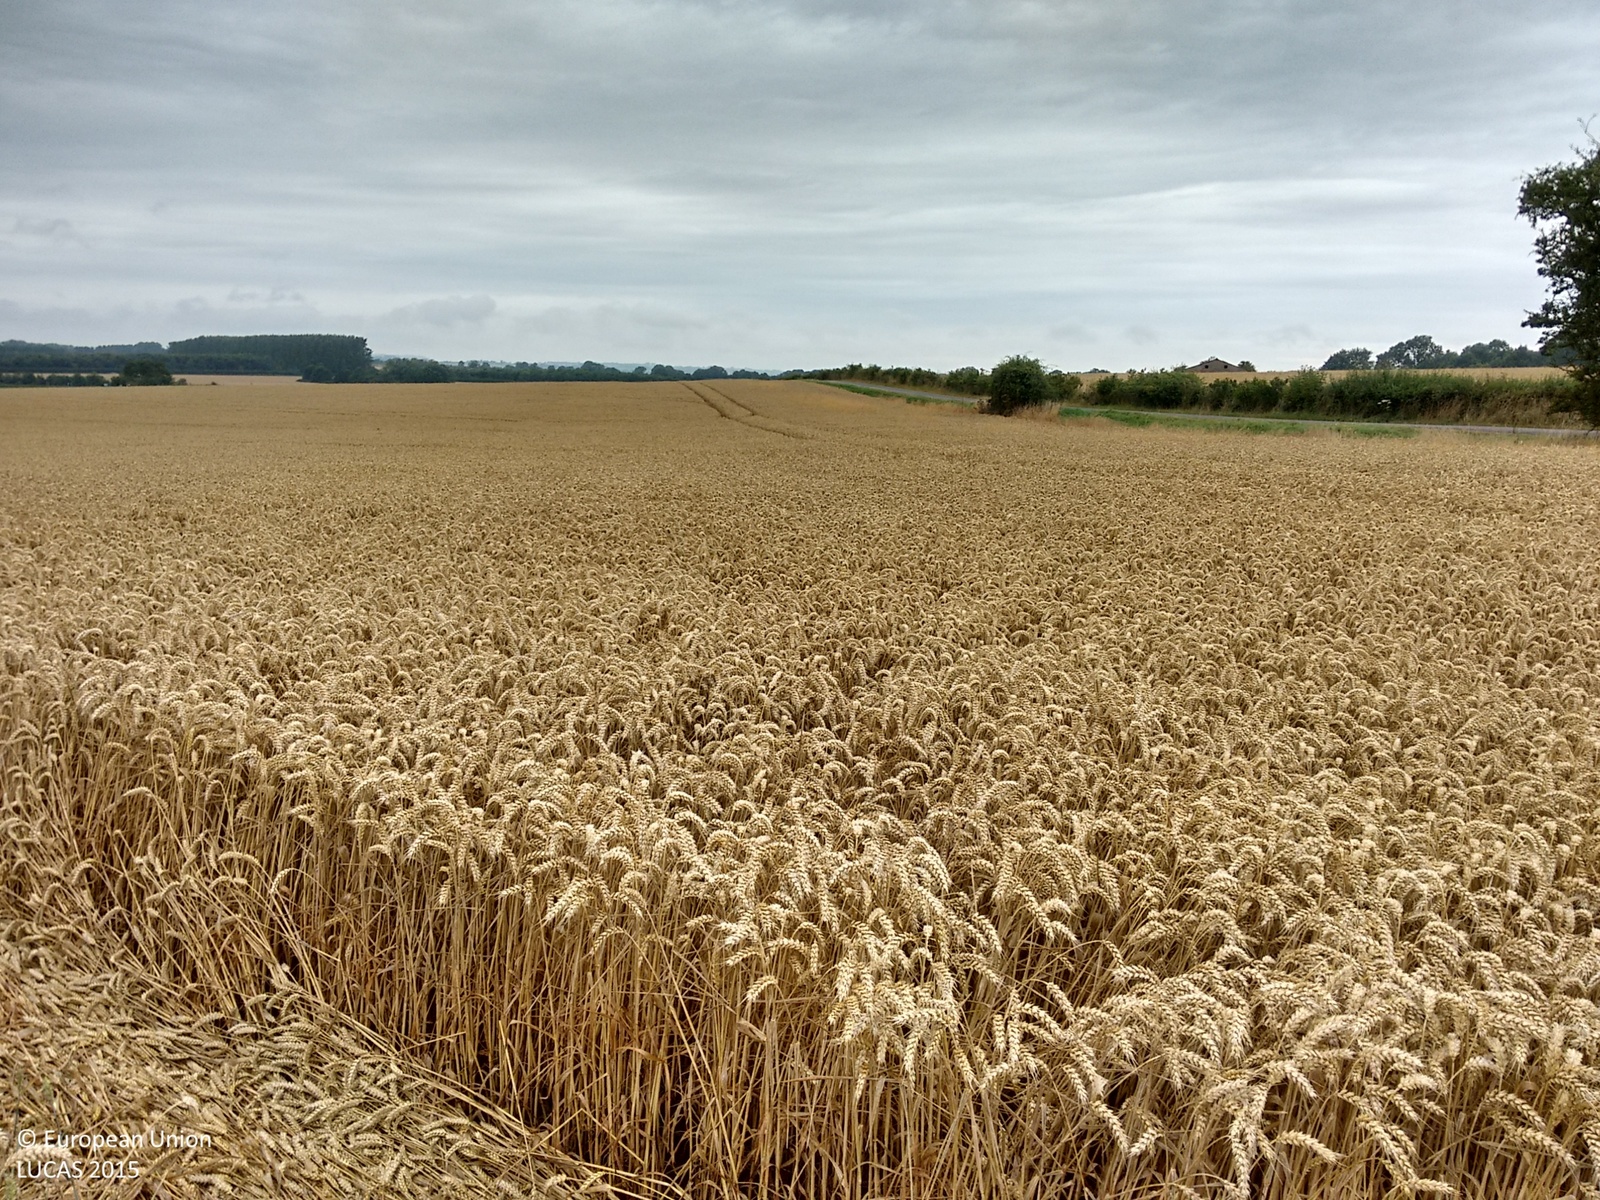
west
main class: Cropland
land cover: Common wheat
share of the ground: > 75 %
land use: Agriculture (excluding fallow land and kitchen gardens)
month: August
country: GB
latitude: 52.1488
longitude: -1.2570
